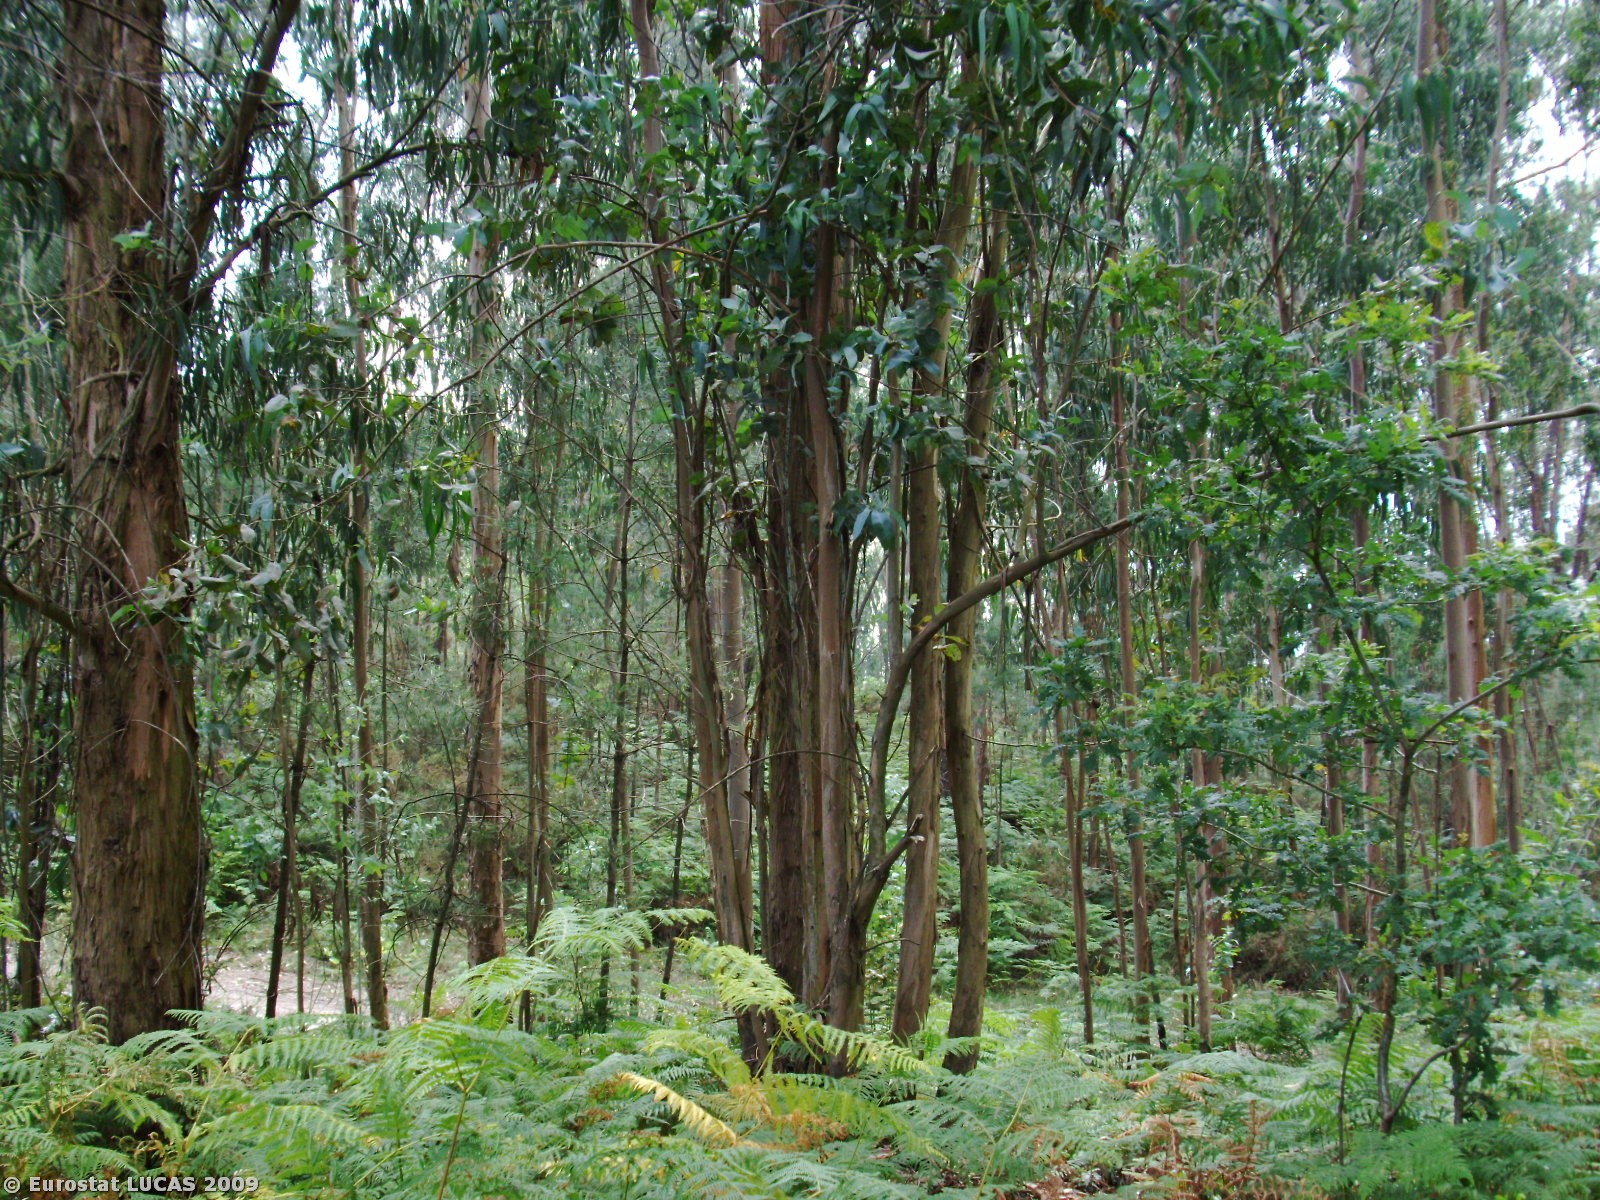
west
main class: Woodland
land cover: Broadleaved woodland
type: plantations and self-sown exotic forest
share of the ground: 50 - 75 %
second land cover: Spontaneously vegetated surfaces
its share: 50 - 75 %
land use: Forestry
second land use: Unused
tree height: > 5 m
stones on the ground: < 10 %
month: June
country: PT
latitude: 41.4357
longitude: -8.4759
